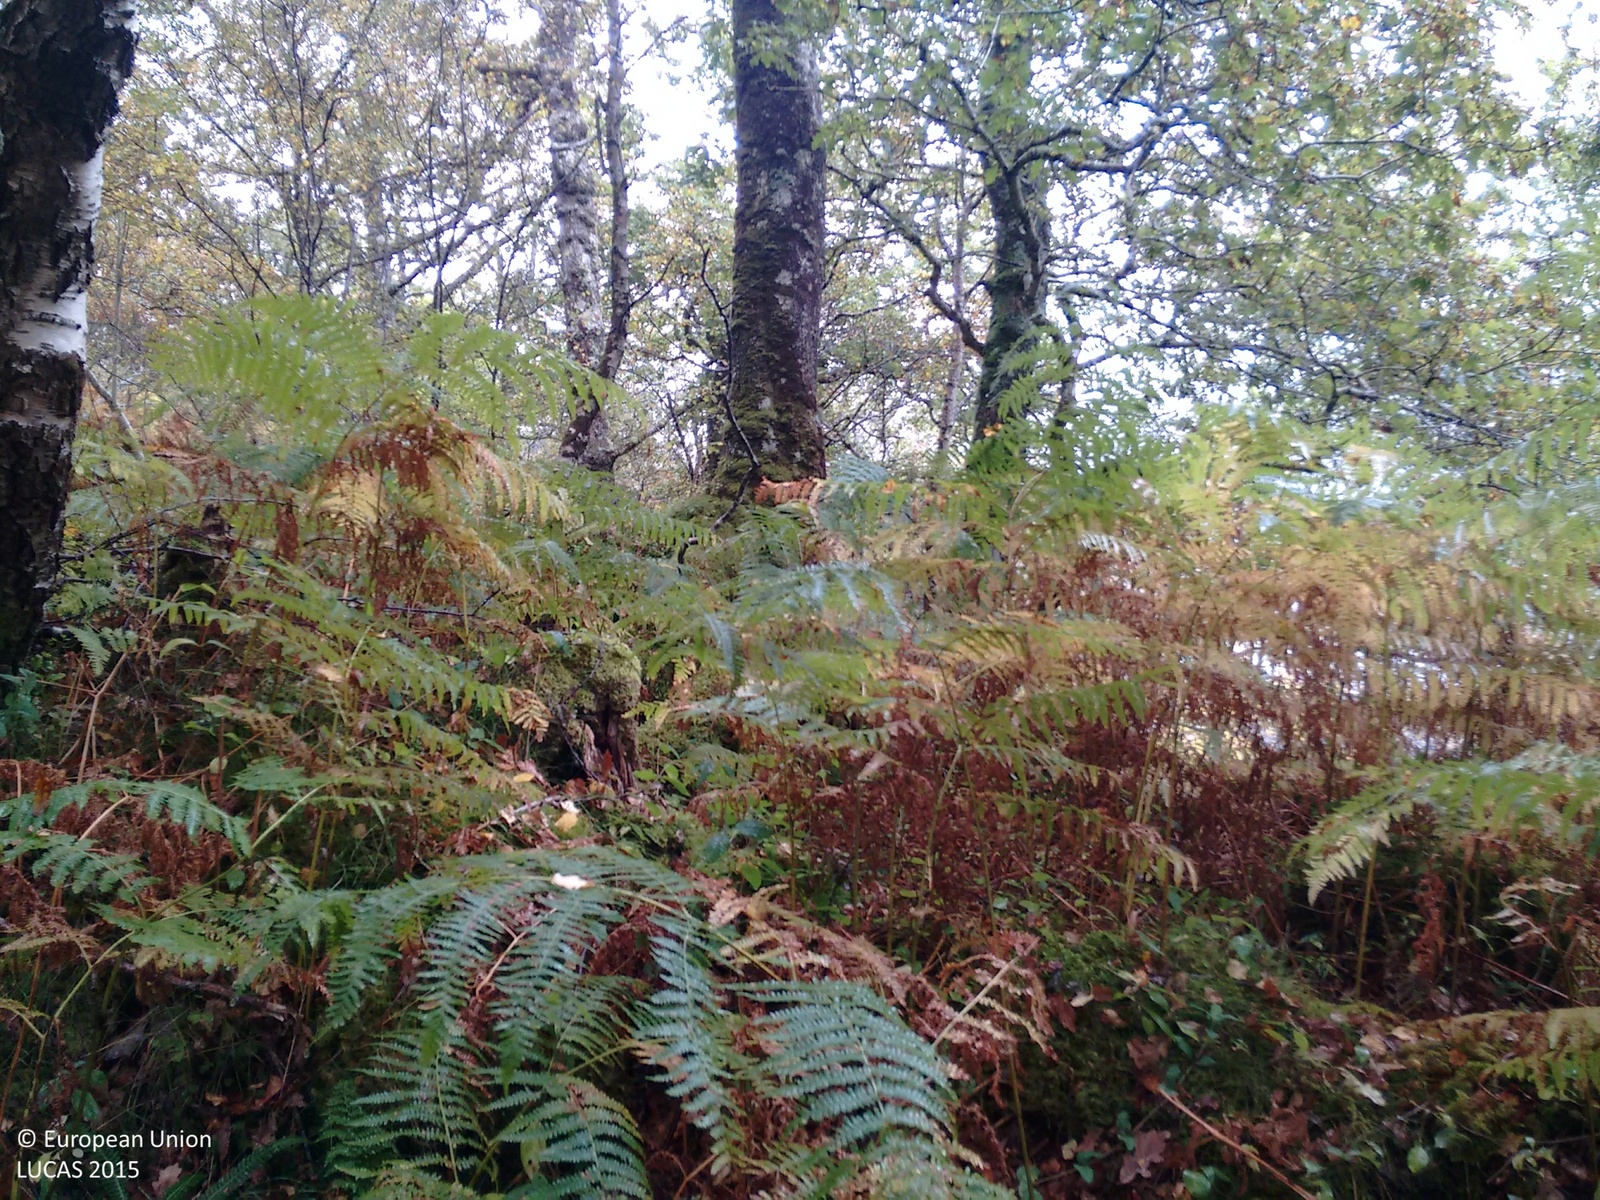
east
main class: Woodland
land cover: Broadleaved woodland
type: acidophilous oak and oak-birch forest
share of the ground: > 75 %
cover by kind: broadleaved forest trees 80 %, shrubs 10 %, herbaceous plants 10 %
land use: Forestry
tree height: > 5 m
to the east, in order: Broadleaved woodland; Sand; Transitional water bodies; Sand; Broadleaved woodland
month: October
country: GB
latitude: 56.6856
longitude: -5.8161
